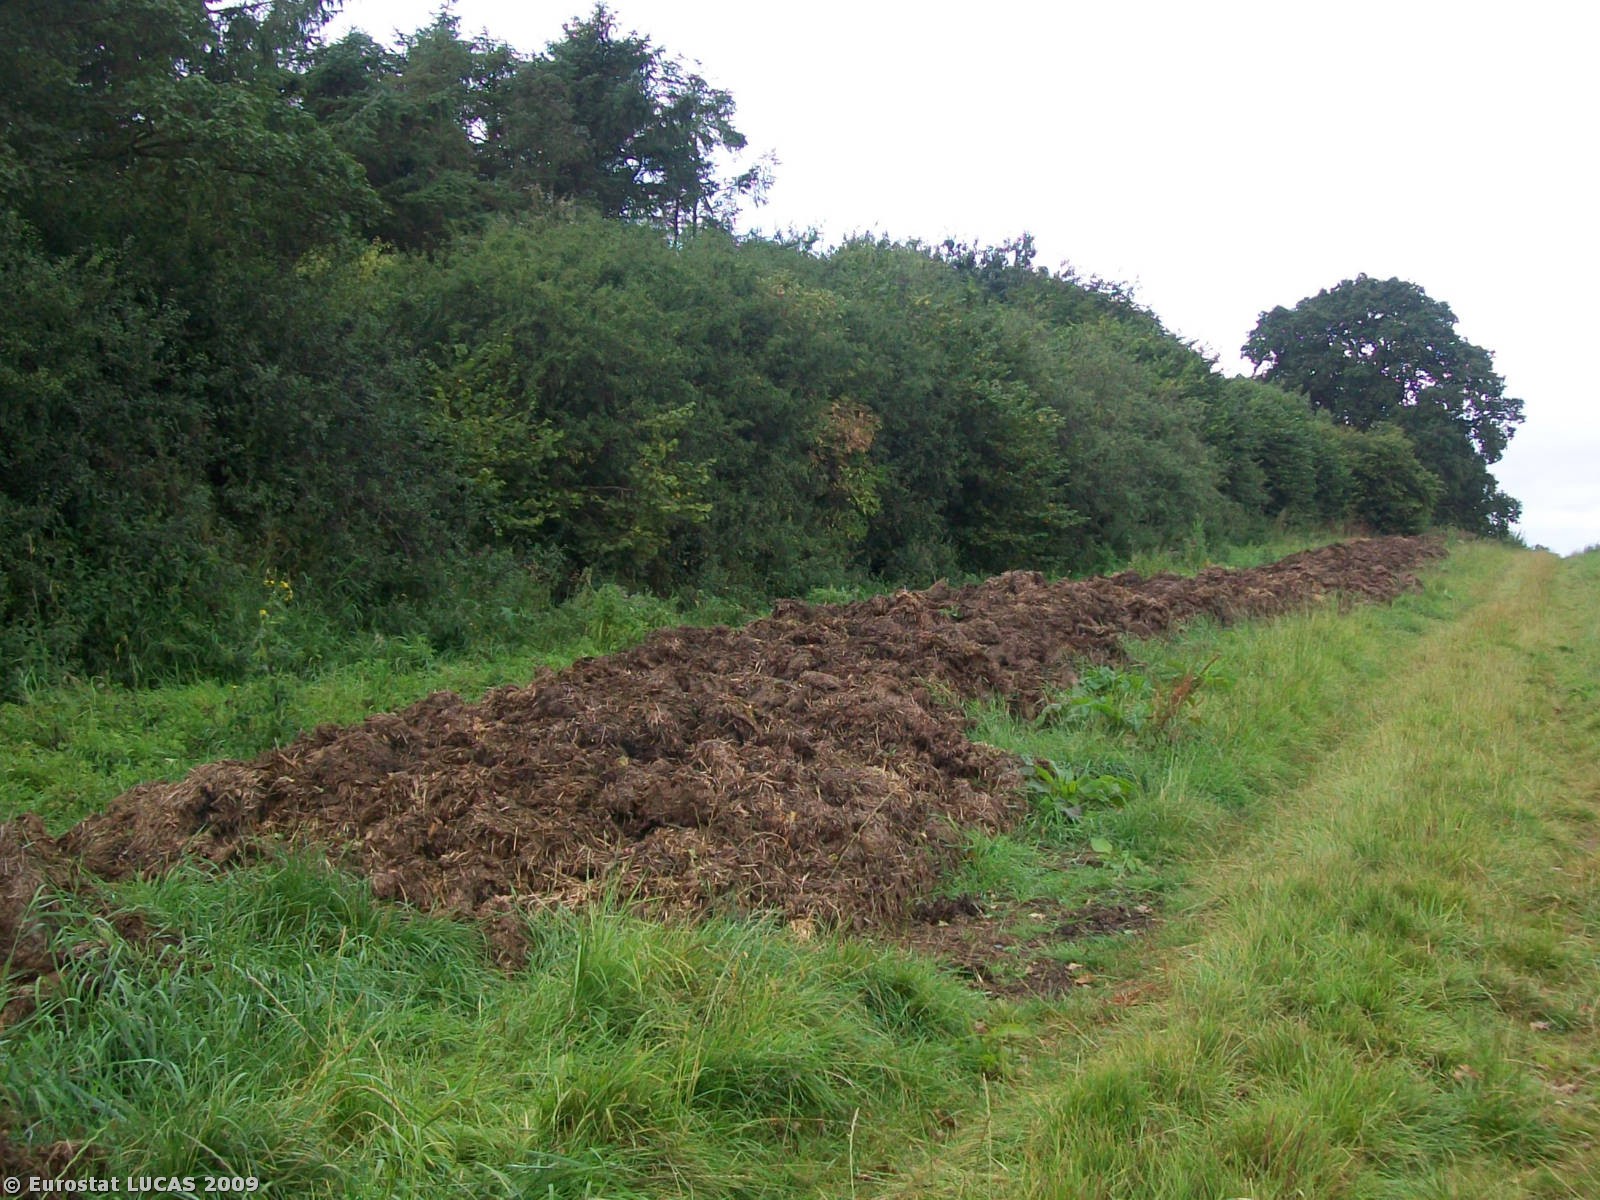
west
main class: Cropland
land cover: Common wheat
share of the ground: > 75 %
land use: Agriculture (excluding fallow land and kitchen gardens)
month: September
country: GB
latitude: 52.5302
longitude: -2.5227
